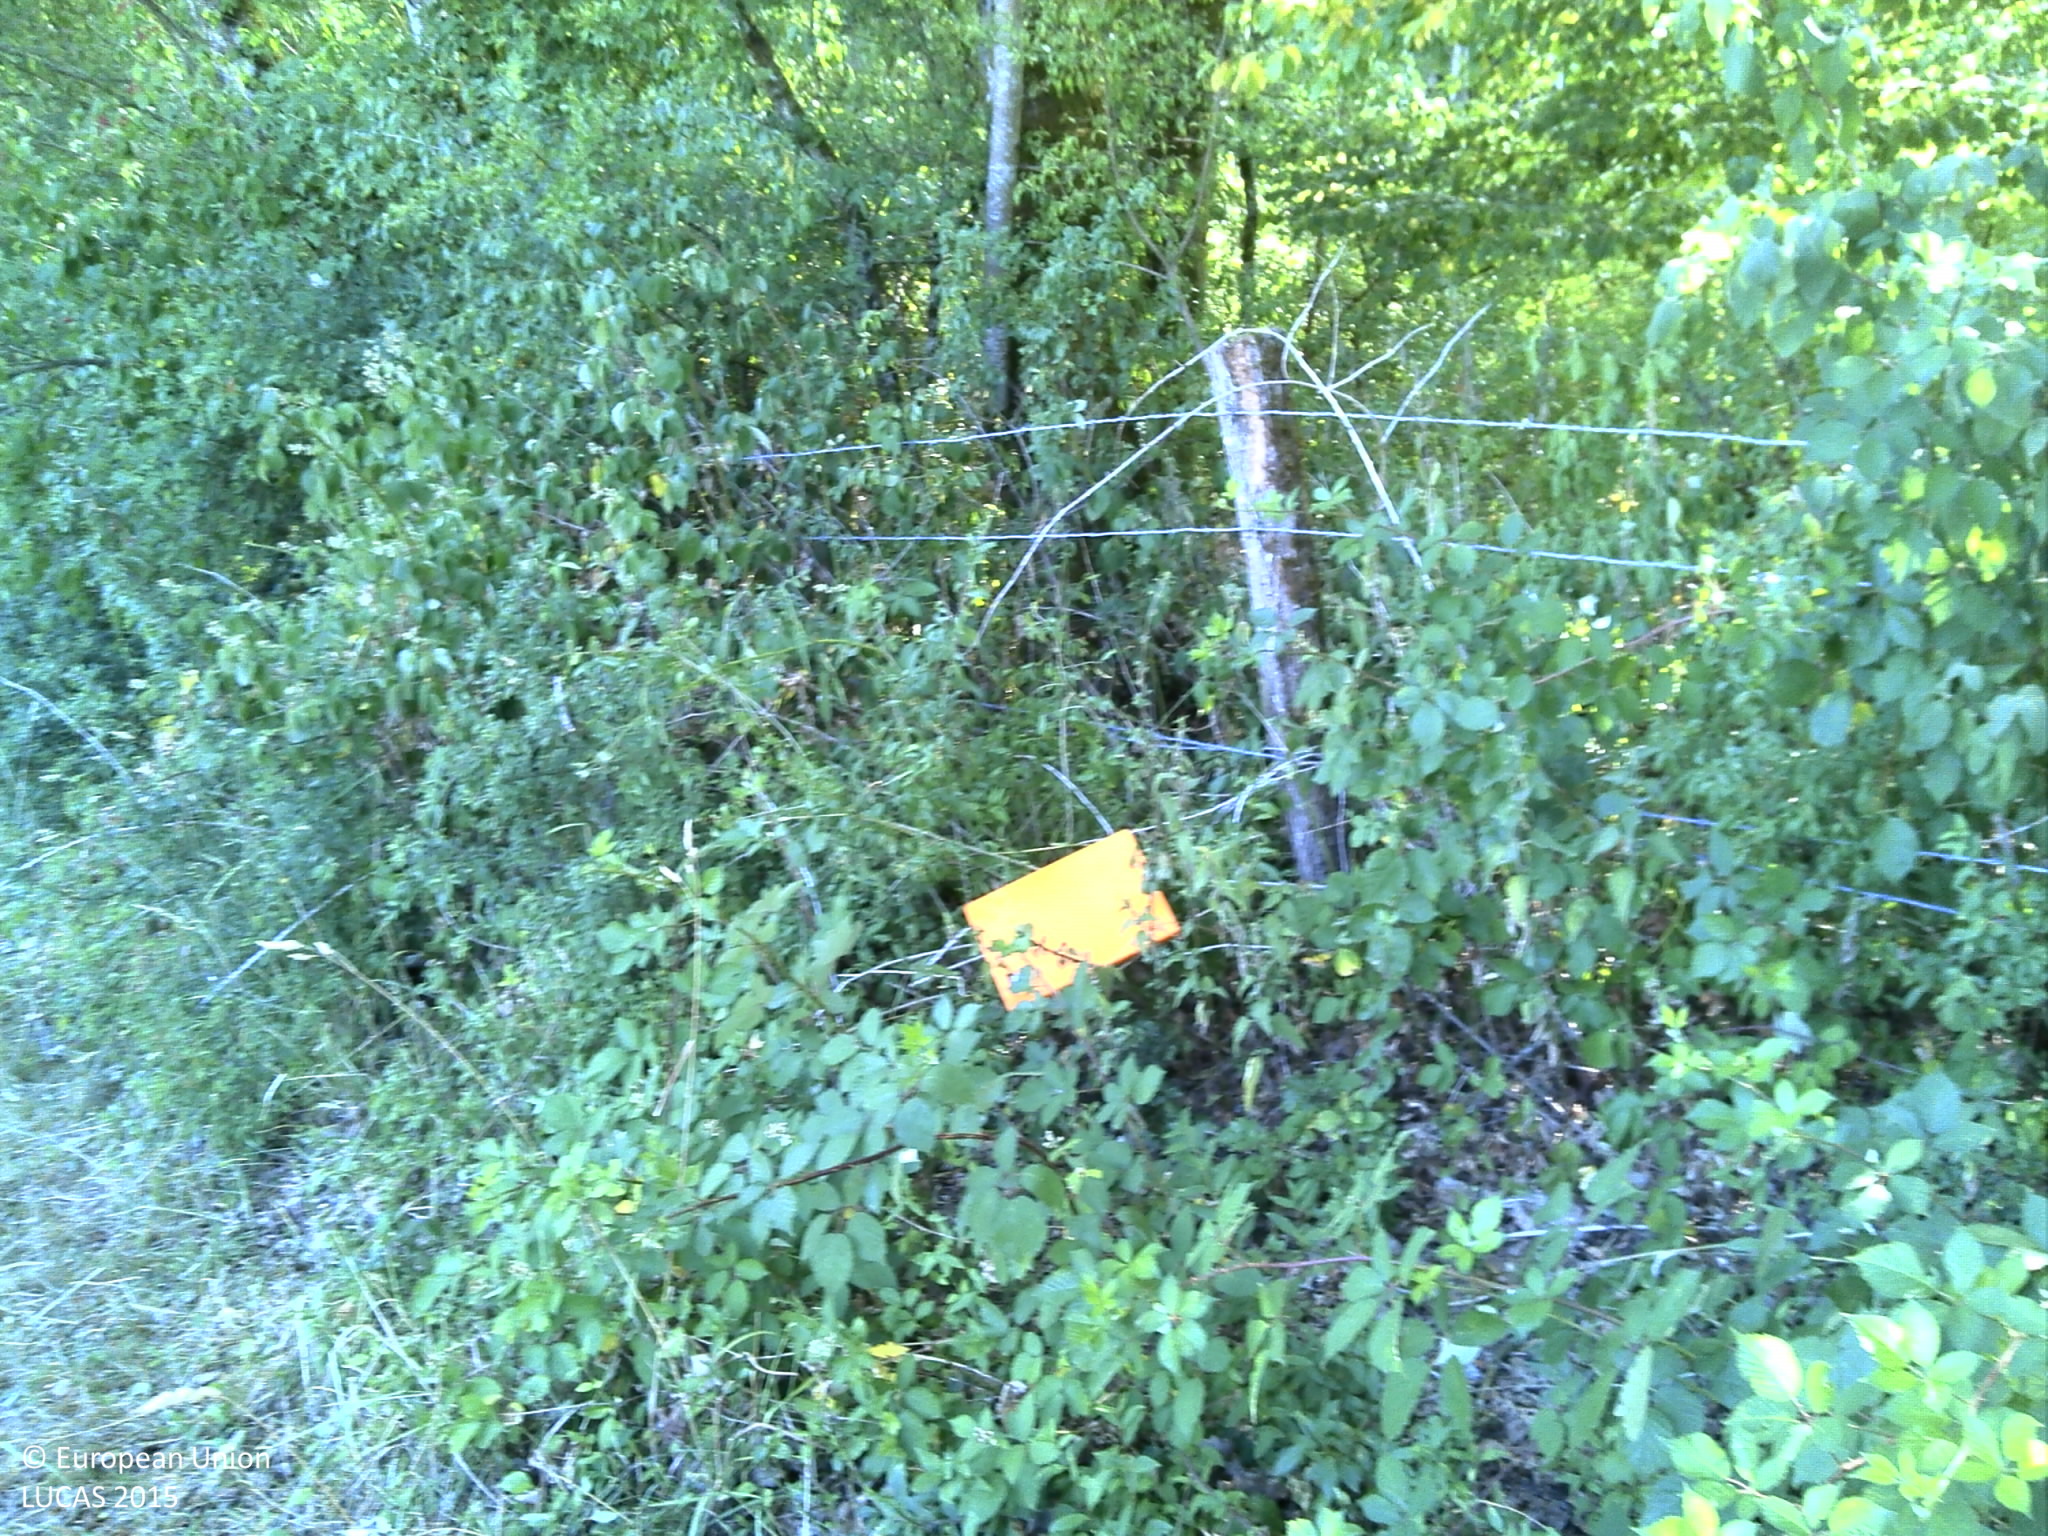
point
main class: Grassland
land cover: Grassland without tree/shrub cover
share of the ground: > 75 %
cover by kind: herbaceous plants 100 %
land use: Agriculture (excluding fallow land and kitchen gardens)
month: July
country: FR
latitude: 48.1966
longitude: 6.2739
